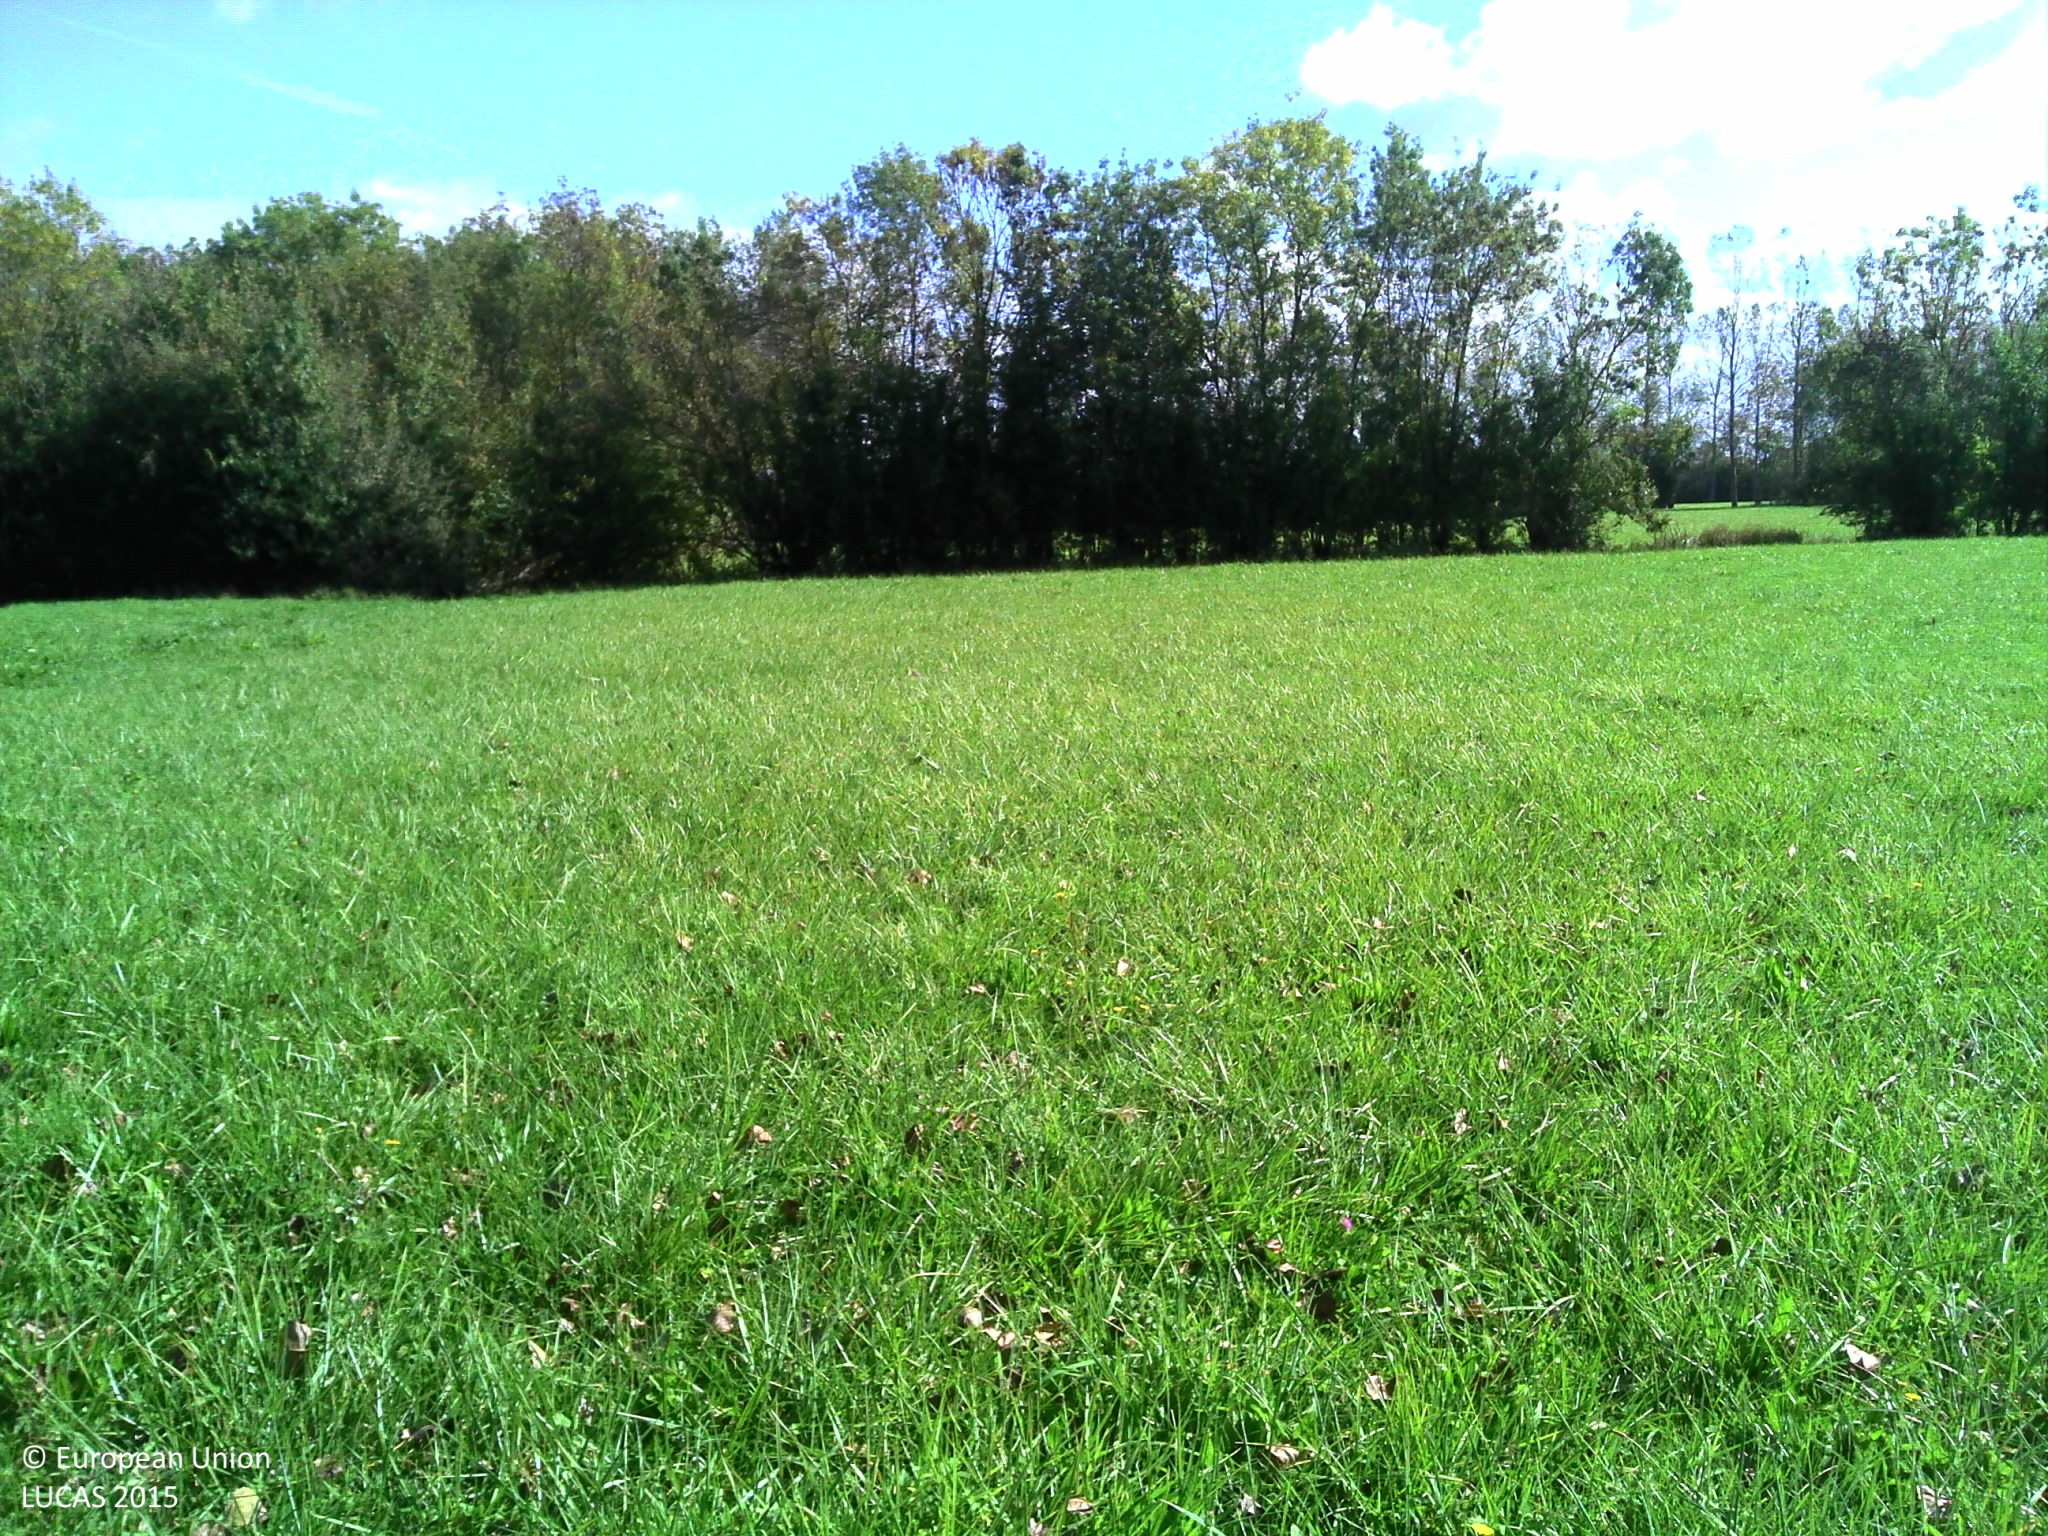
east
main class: Grassland
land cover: Grassland without tree/shrub cover
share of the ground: > 75 %
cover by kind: herbaceous plants 100 %
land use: Agriculture (excluding fallow land and kitchen gardens)
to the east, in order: Grassland without tree/shrub cover; Ditches and canals; Broadleaved woodland; Grassland without tree/shrub cover; Broadleaved woodland; Ditches and canals; Lines of trees; Grassland without tree/shrub cover
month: October
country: FR
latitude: 46.3475
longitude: -0.8010
